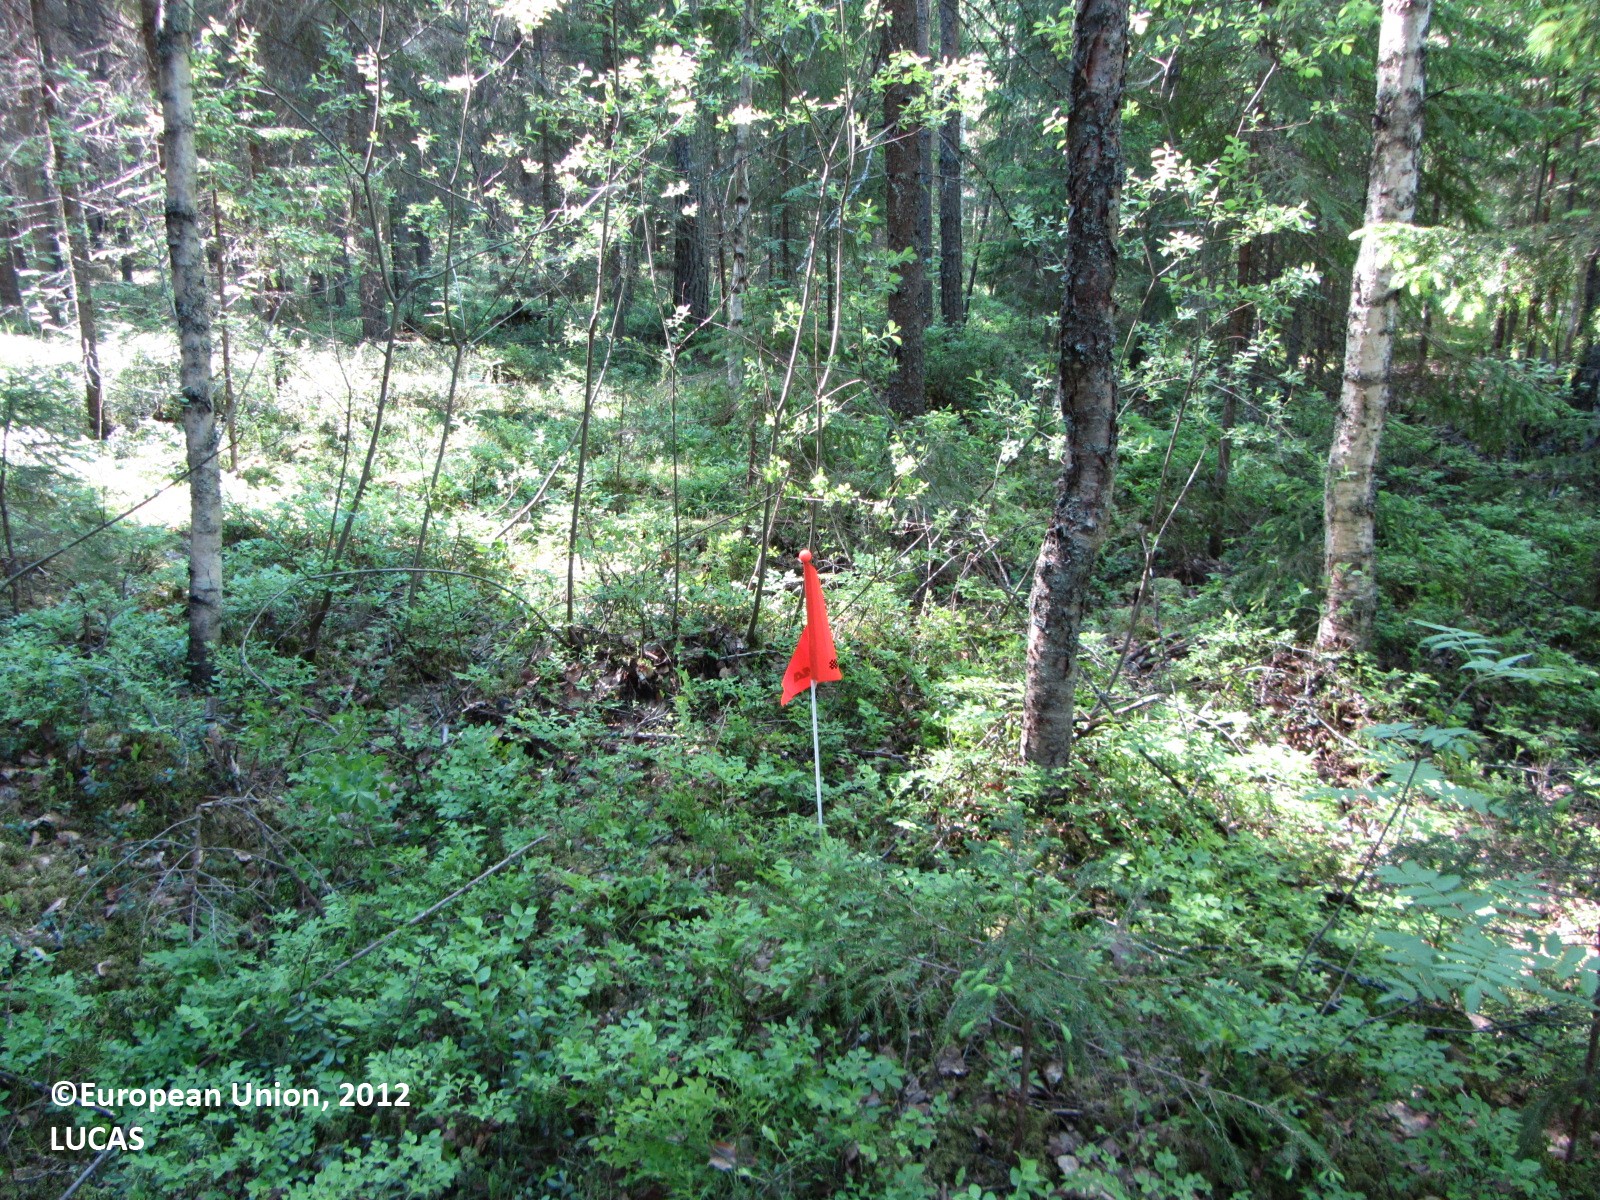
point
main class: Woodland
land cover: Spruce dominated coniferous woodland
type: boreal forest
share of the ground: 50 - 75 %
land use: Forestry
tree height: > 5 m
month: June
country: FI
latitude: 61.9639
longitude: 24.6490
